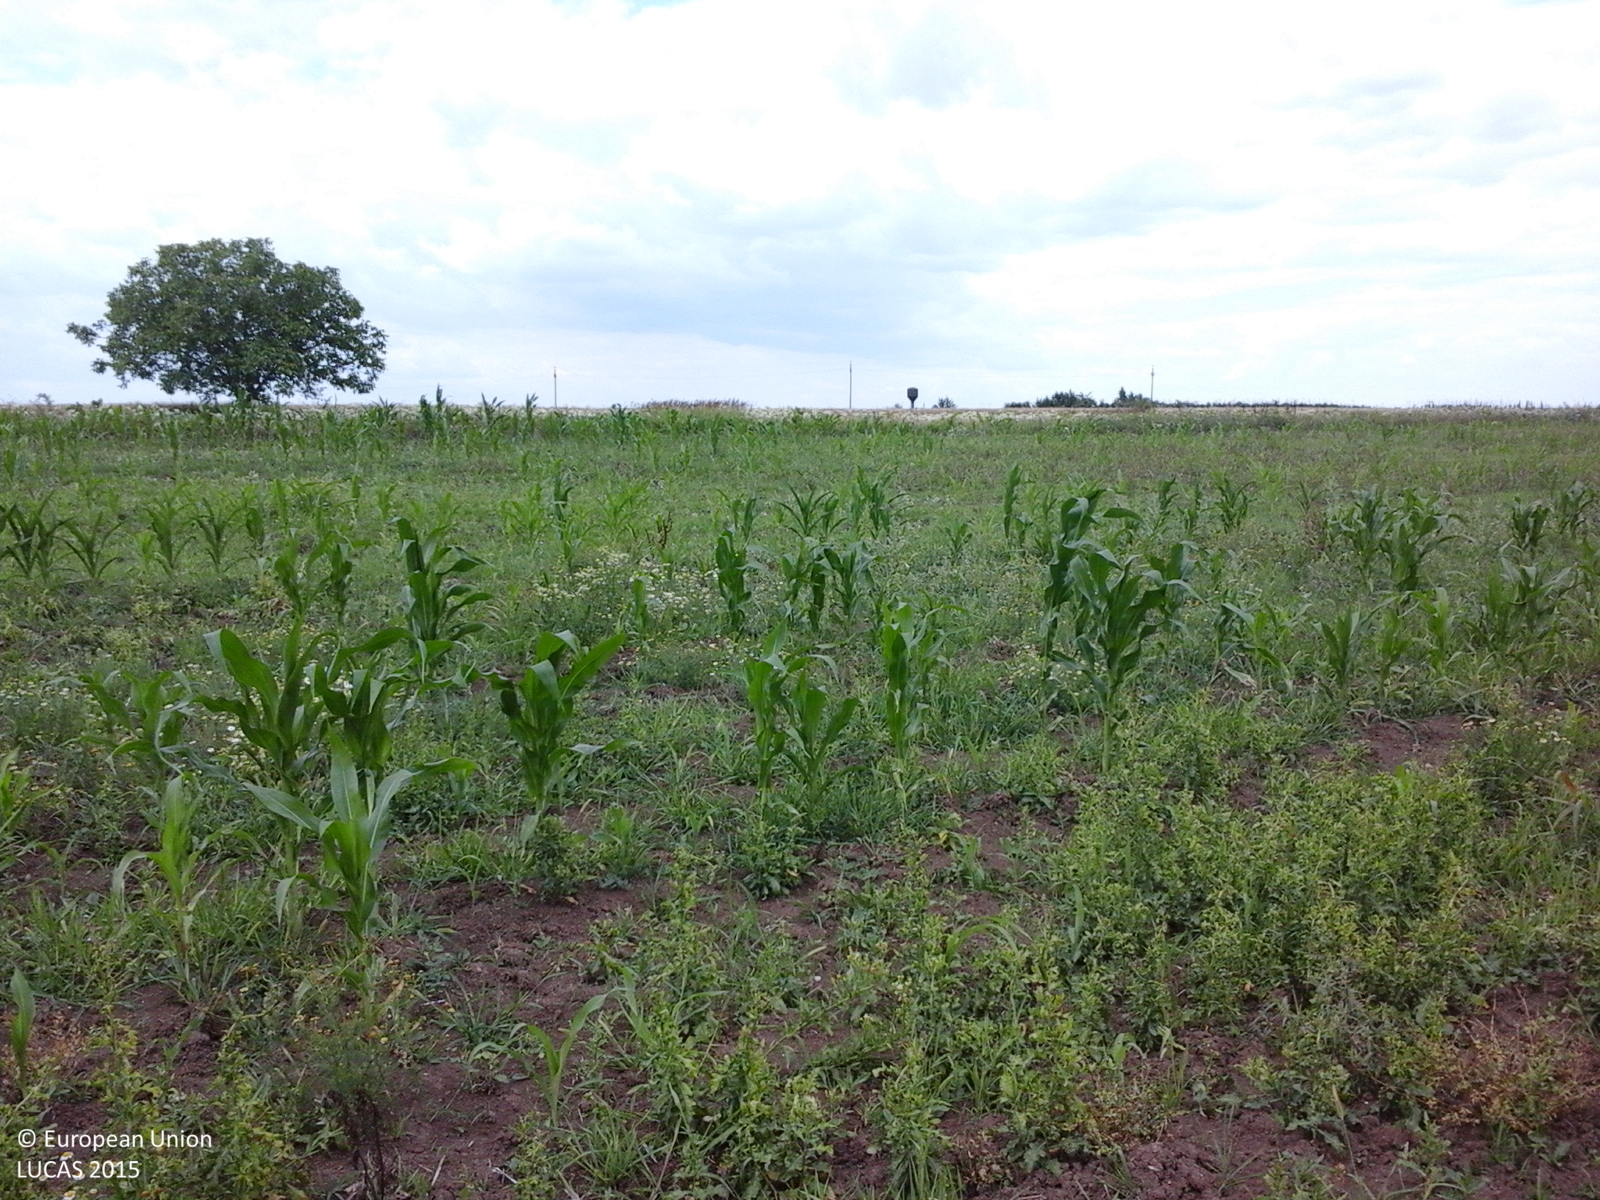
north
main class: Cropland
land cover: Maize
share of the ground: 25 - 50 %
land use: Agriculture (excluding fallow land and kitchen gardens)
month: July
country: RO
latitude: 44.3001
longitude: 24.7262
